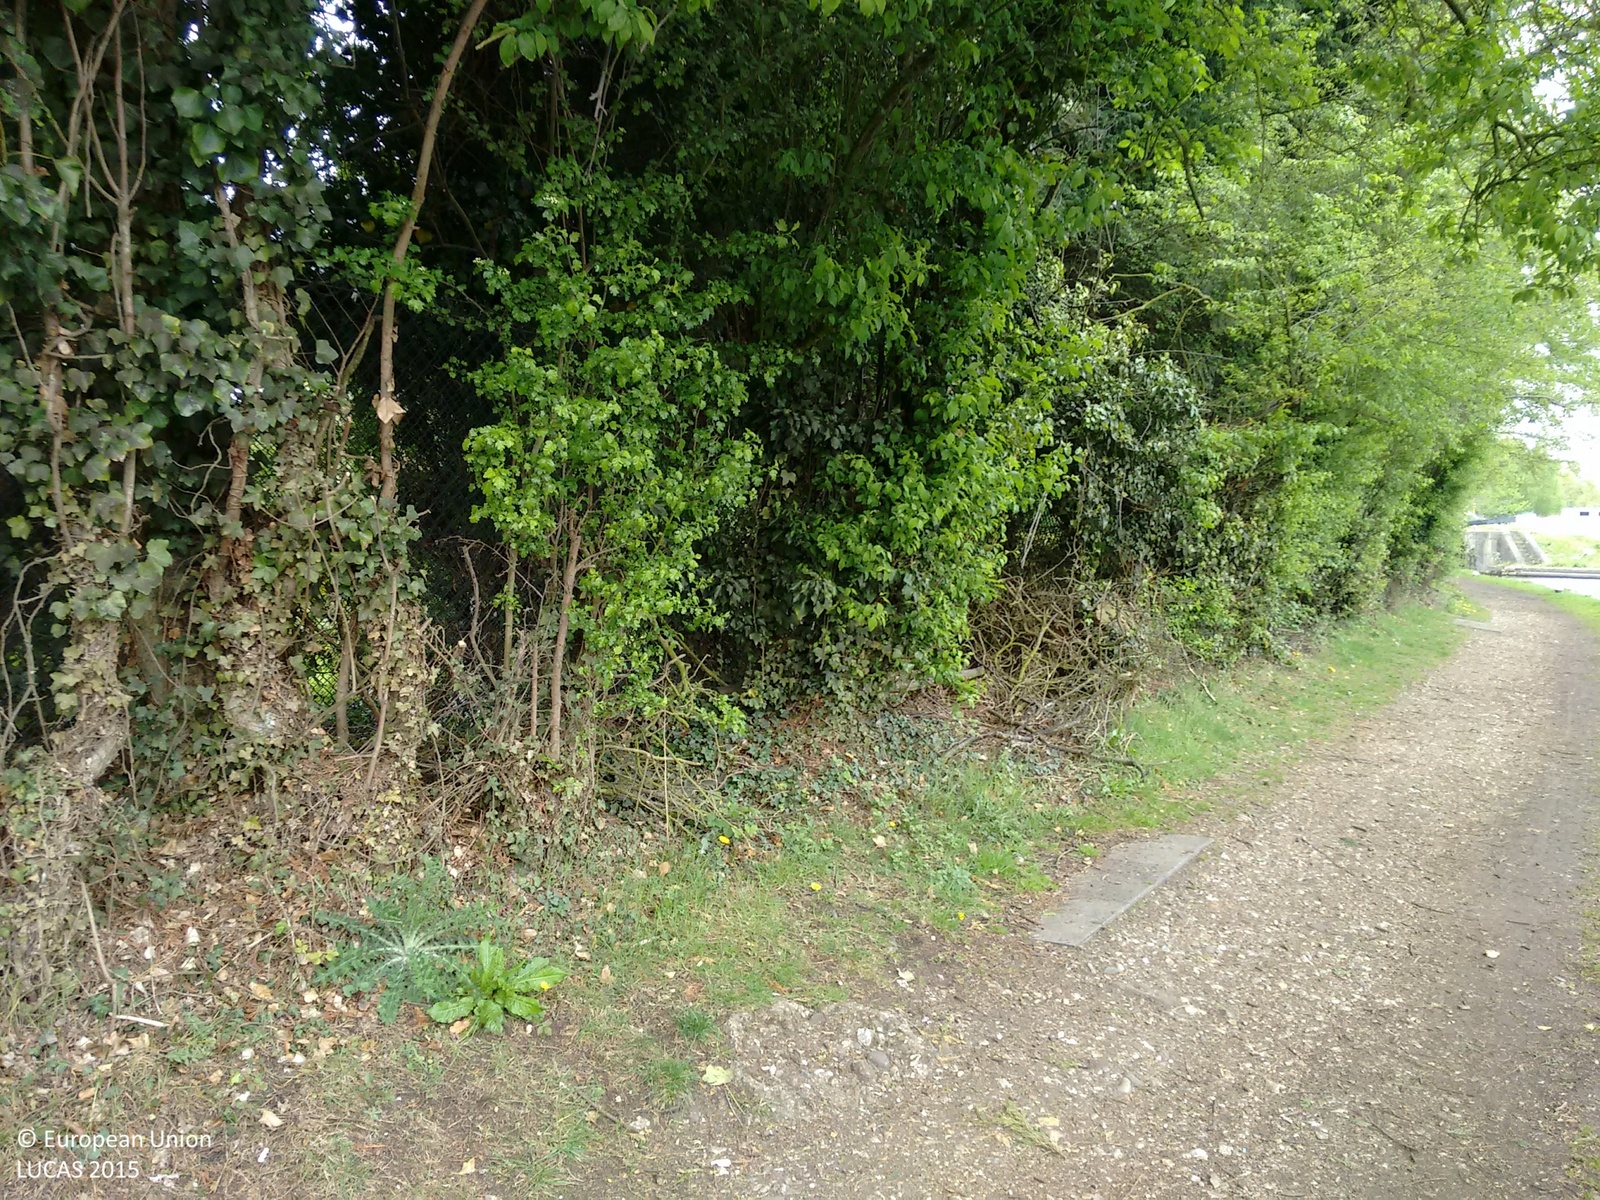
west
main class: Grassland
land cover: Grassland without tree/shrub cover
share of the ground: > 75 %
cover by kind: herbaceous plants 100 %
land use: Amenities, museums, leisure
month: May
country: GB
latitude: 51.7463
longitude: -0.5103
